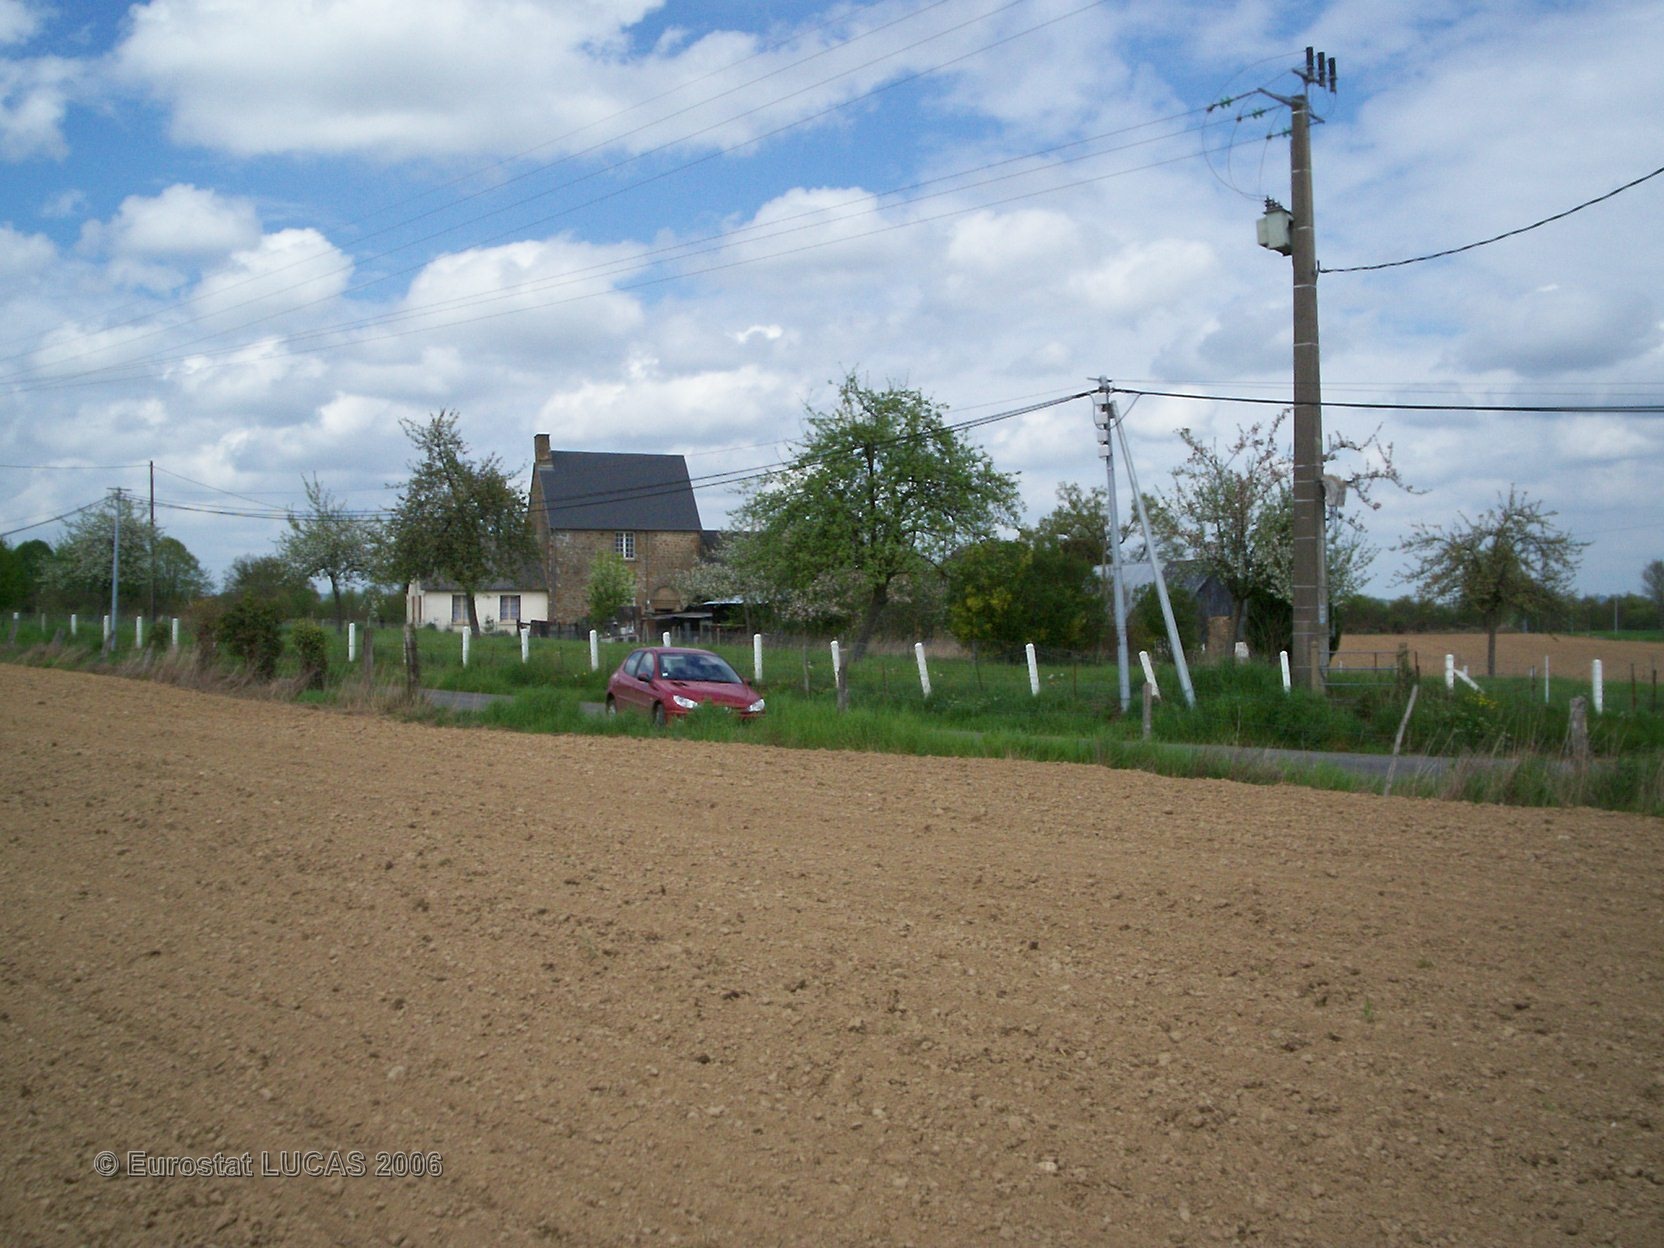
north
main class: Cropland
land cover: Maize
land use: Agriculture (excluding fallow land and kitchen gardens)
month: May
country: FR
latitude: 48.5694
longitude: -0.7303
